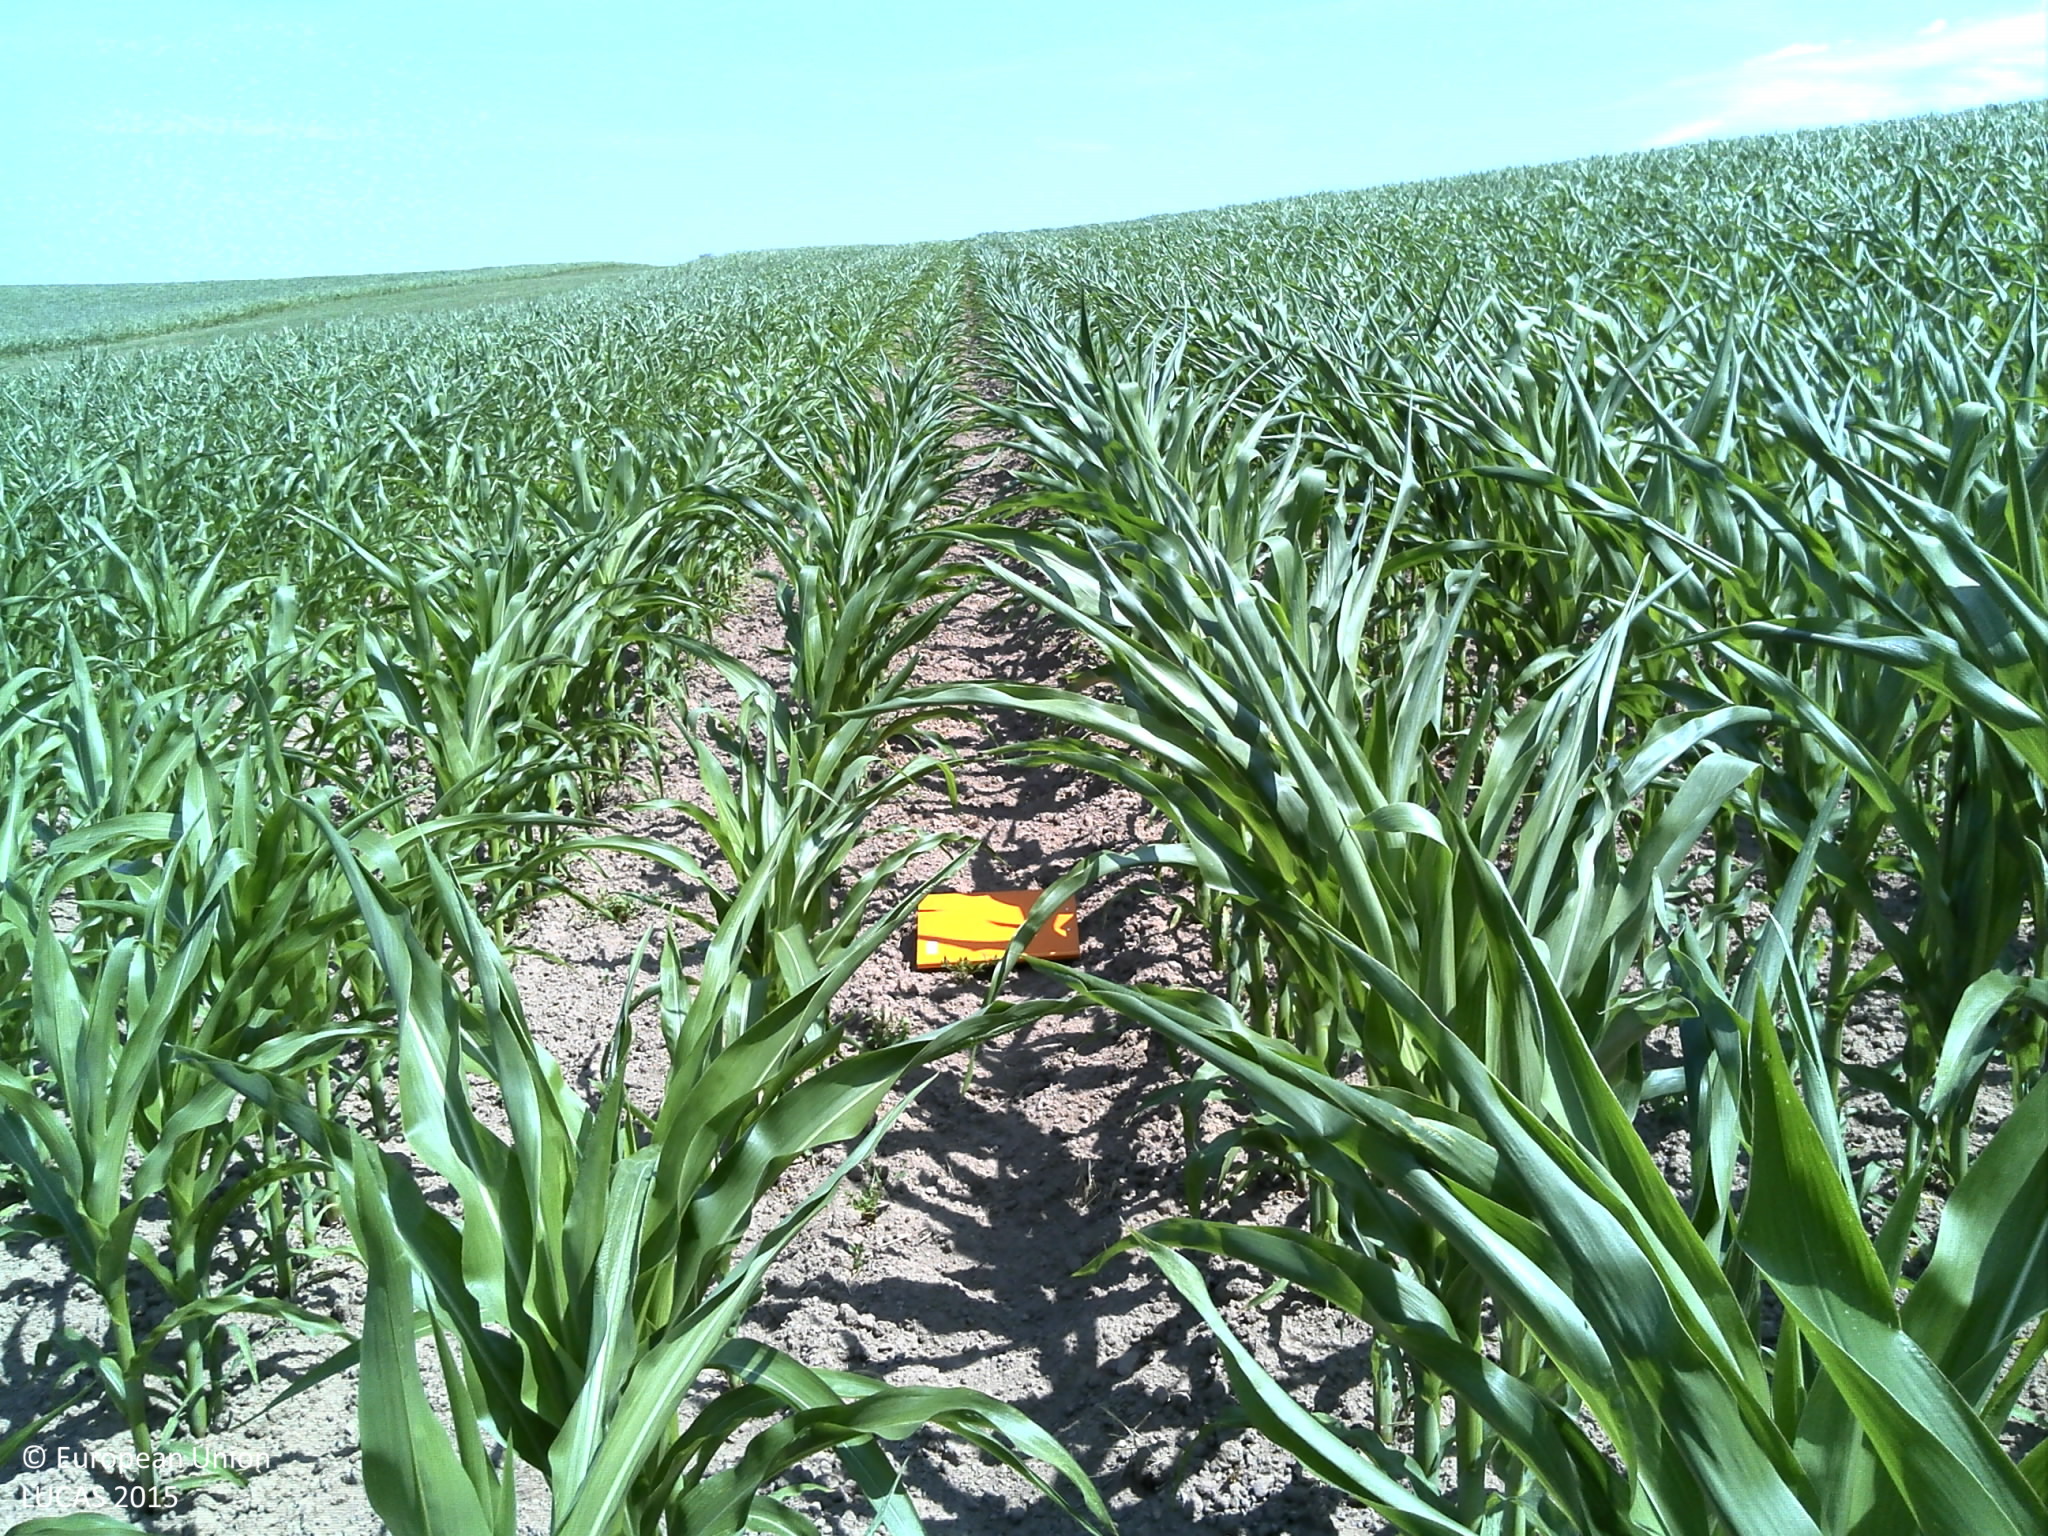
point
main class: Cropland
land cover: Maize
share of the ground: > 75 %
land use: Agriculture (excluding fallow land and kitchen gardens)
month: July
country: FR
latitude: 48.0538
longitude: 6.3112
